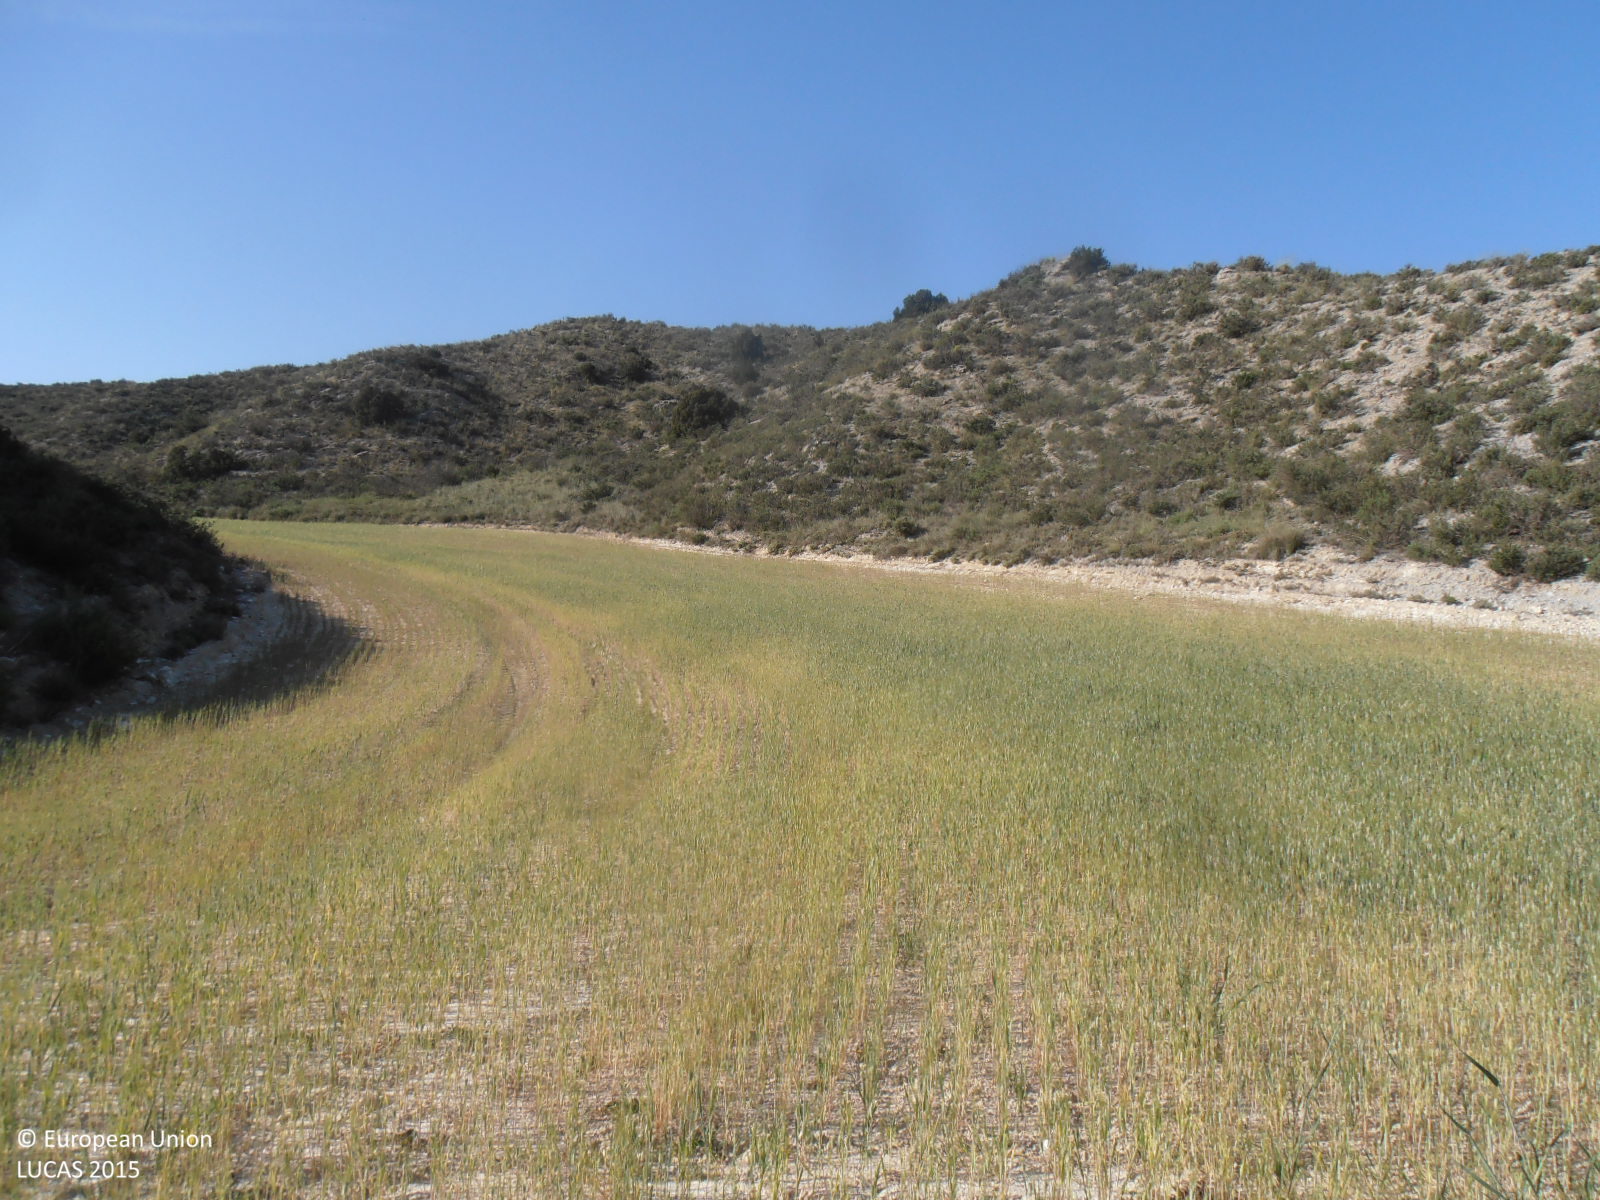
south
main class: Cropland
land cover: Durum wheat
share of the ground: > 75 %
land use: Agriculture (excluding fallow land and kitchen gardens)
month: May
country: ES
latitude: 41.5496
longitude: -0.7738
